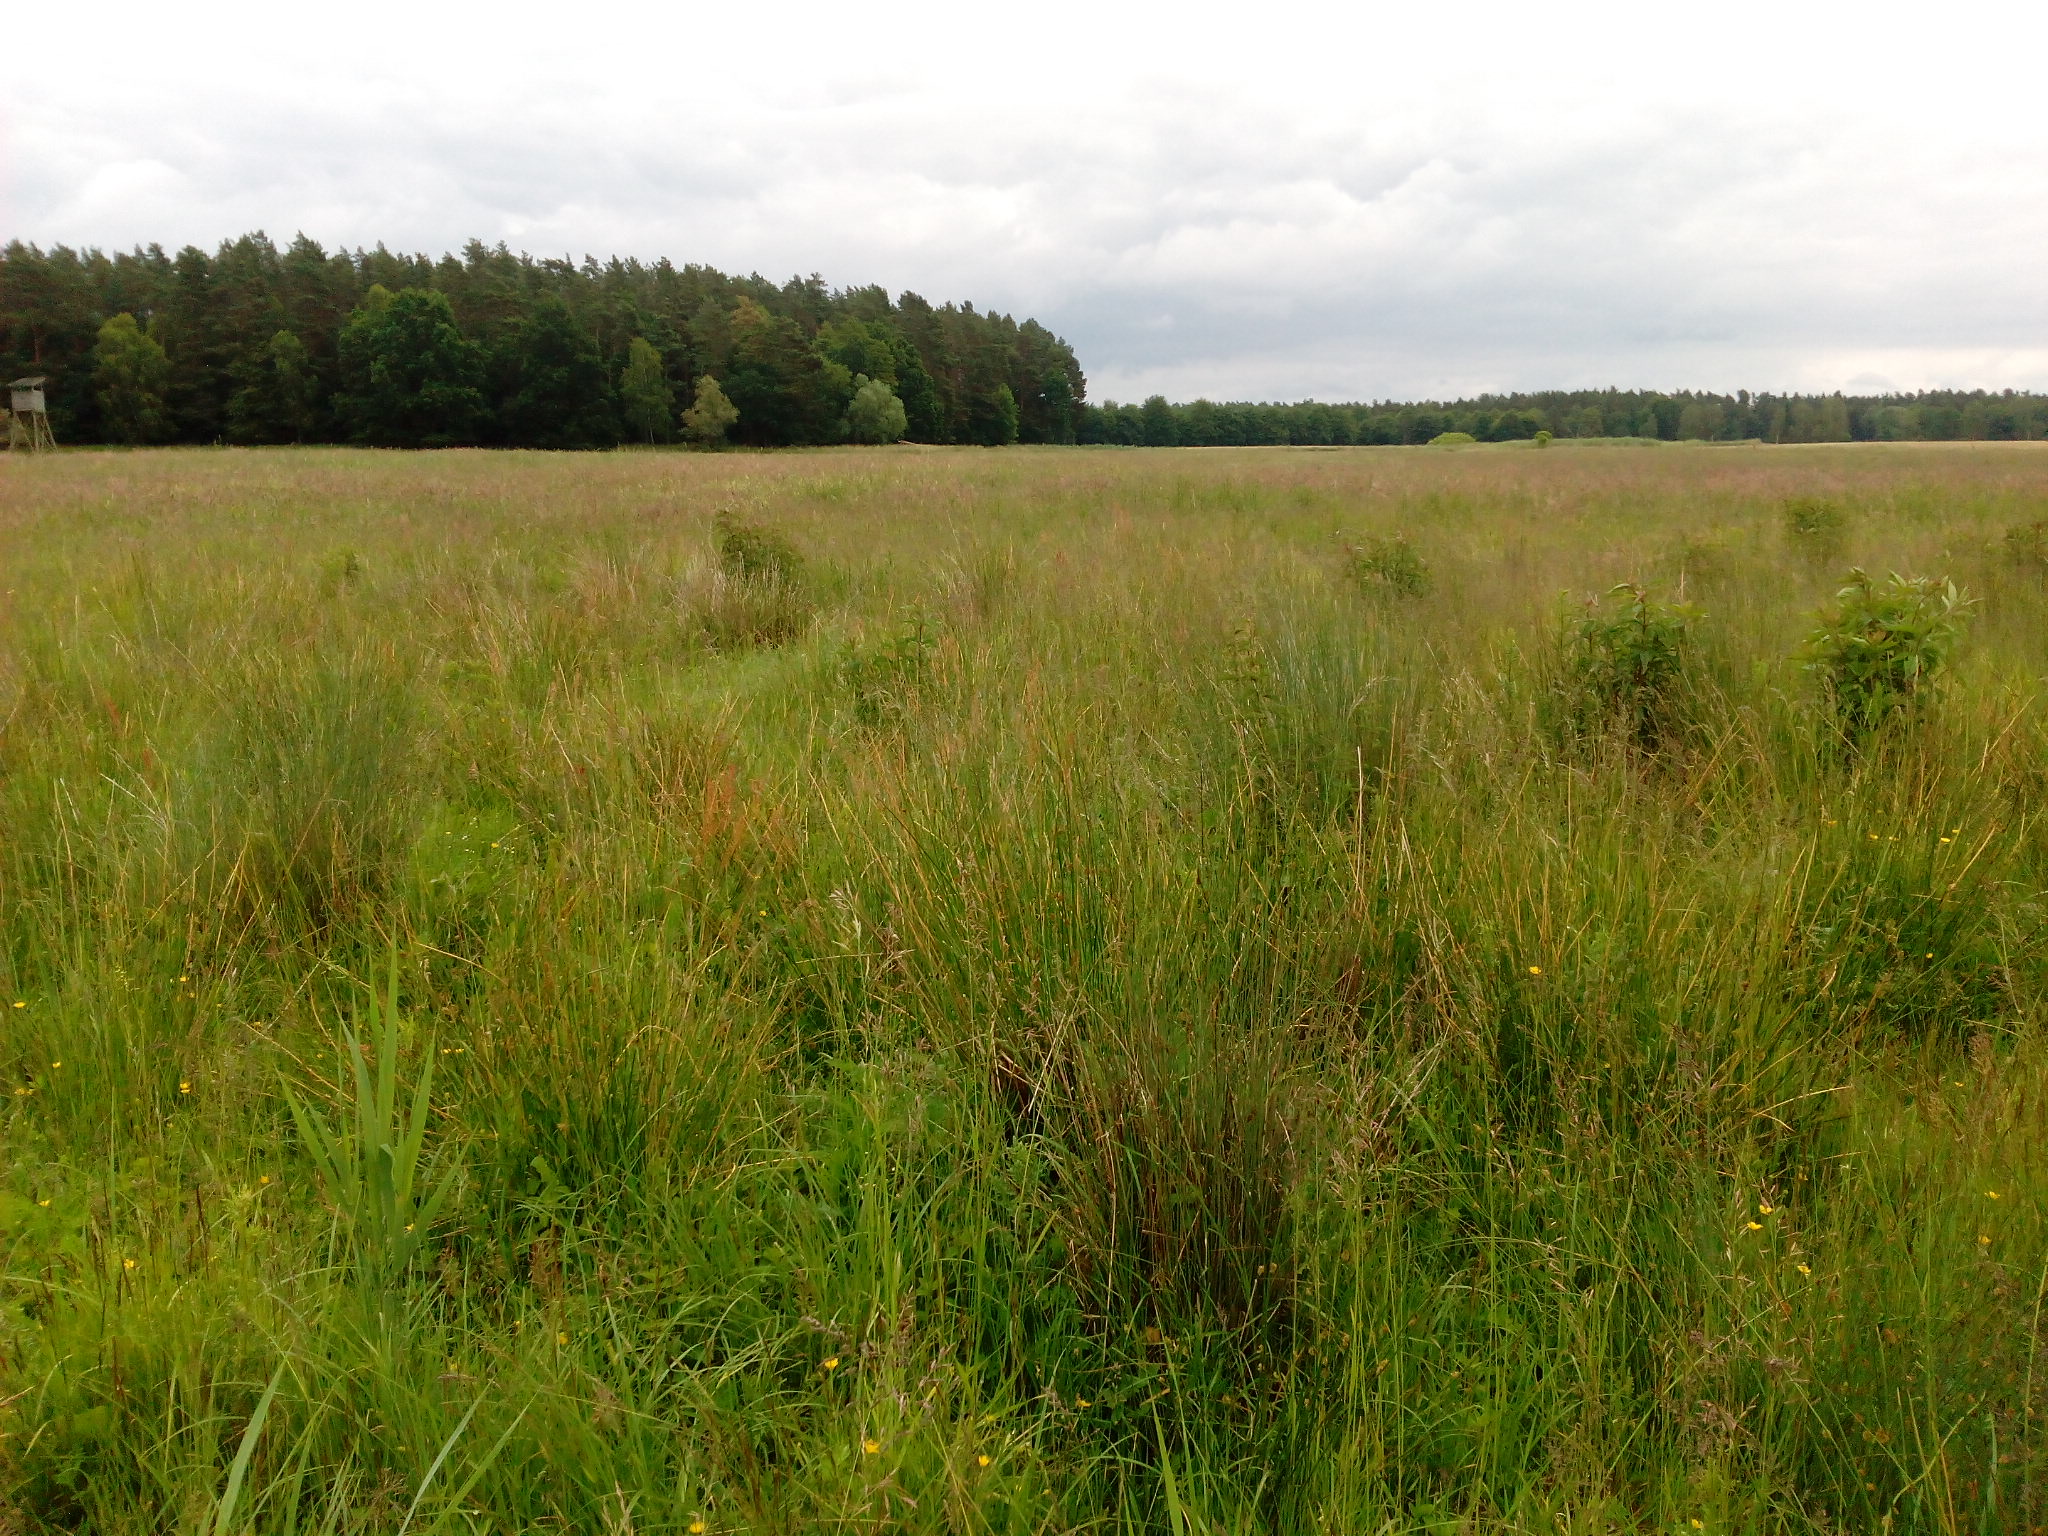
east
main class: Grassland
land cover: Grassland without tree/shrub cover
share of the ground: > 75 %
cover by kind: herbaceous plants 100 %
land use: Agriculture (excluding fallow land and kitchen gardens)
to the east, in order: Grassland without tree/shrub cover; Ditches and canals; Grassland without tree/shrub cover
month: June
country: DE
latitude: 53.1084
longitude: 13.1815
